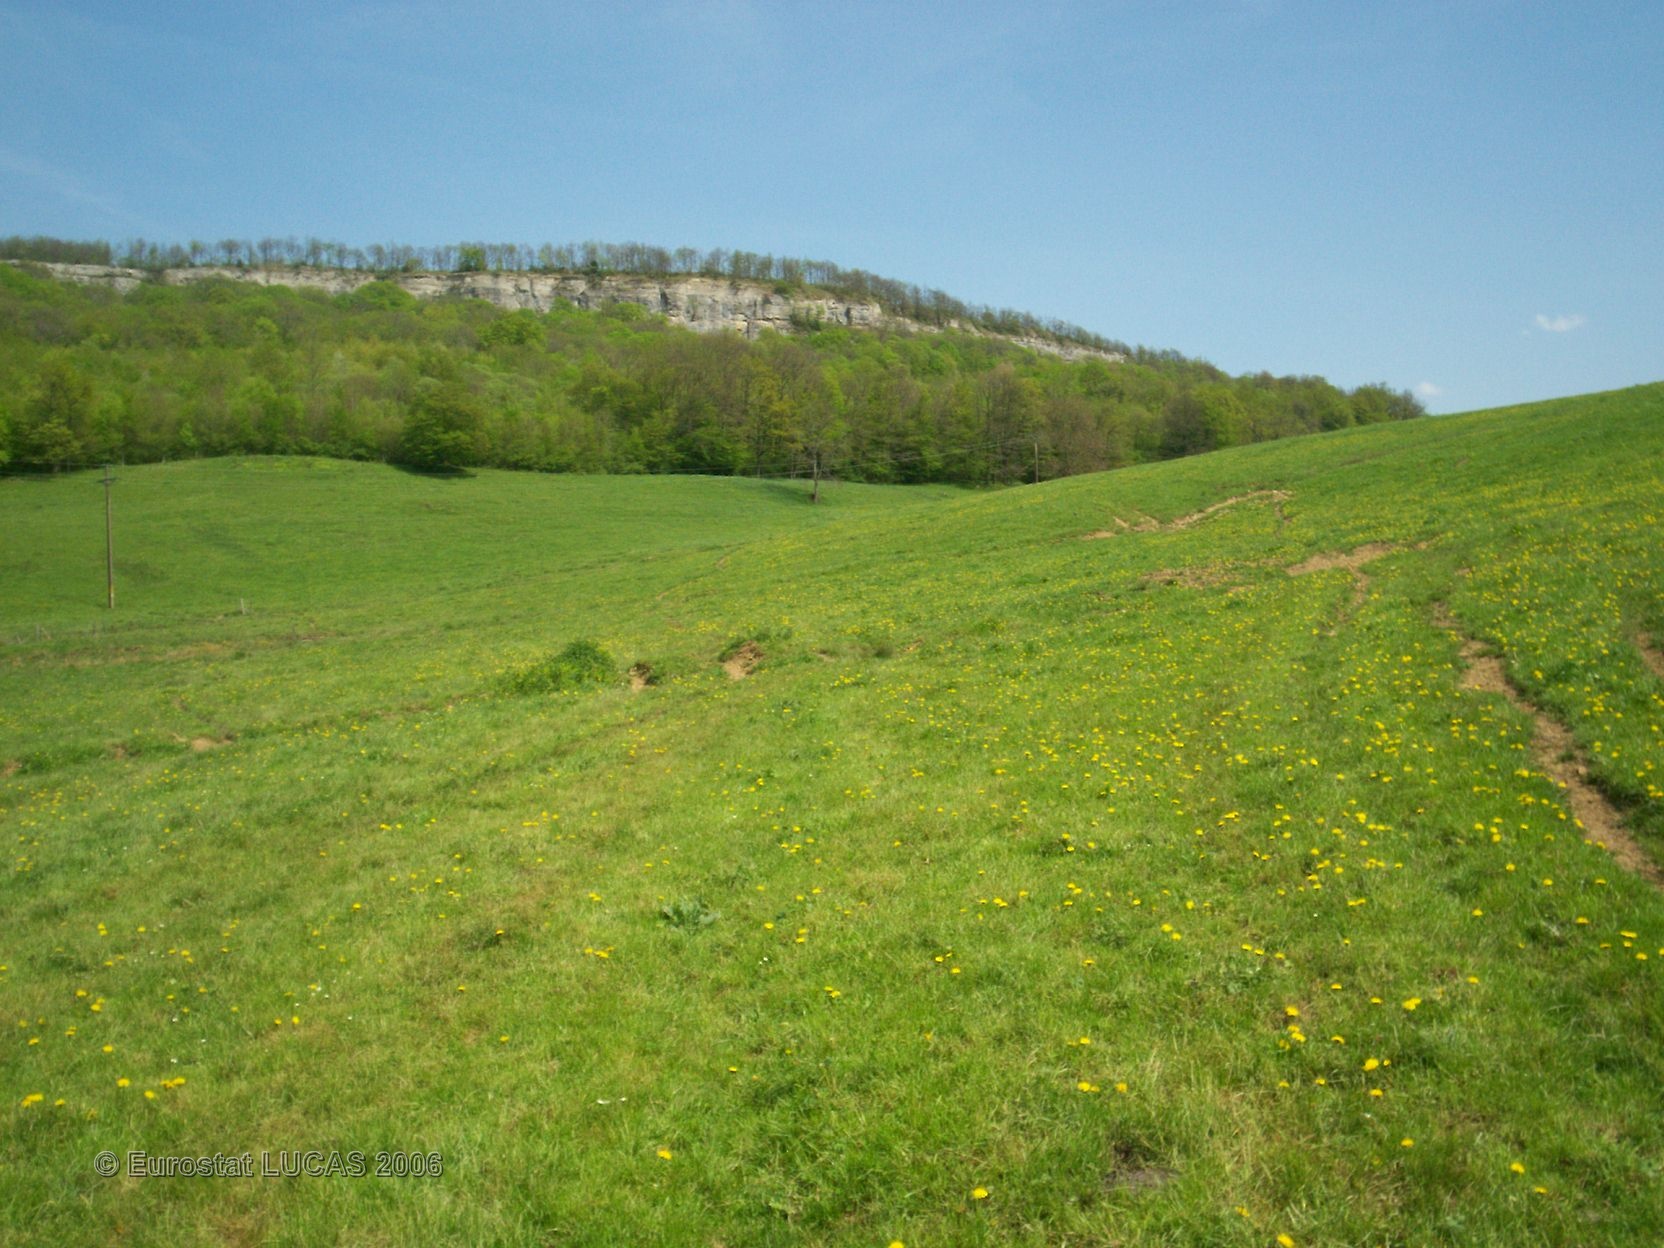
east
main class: Grassland
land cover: Grassland without tree/shrub cover
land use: Agriculture (excluding fallow land and kitchen gardens)
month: May
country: FR
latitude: 47.4779
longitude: 4.5986
